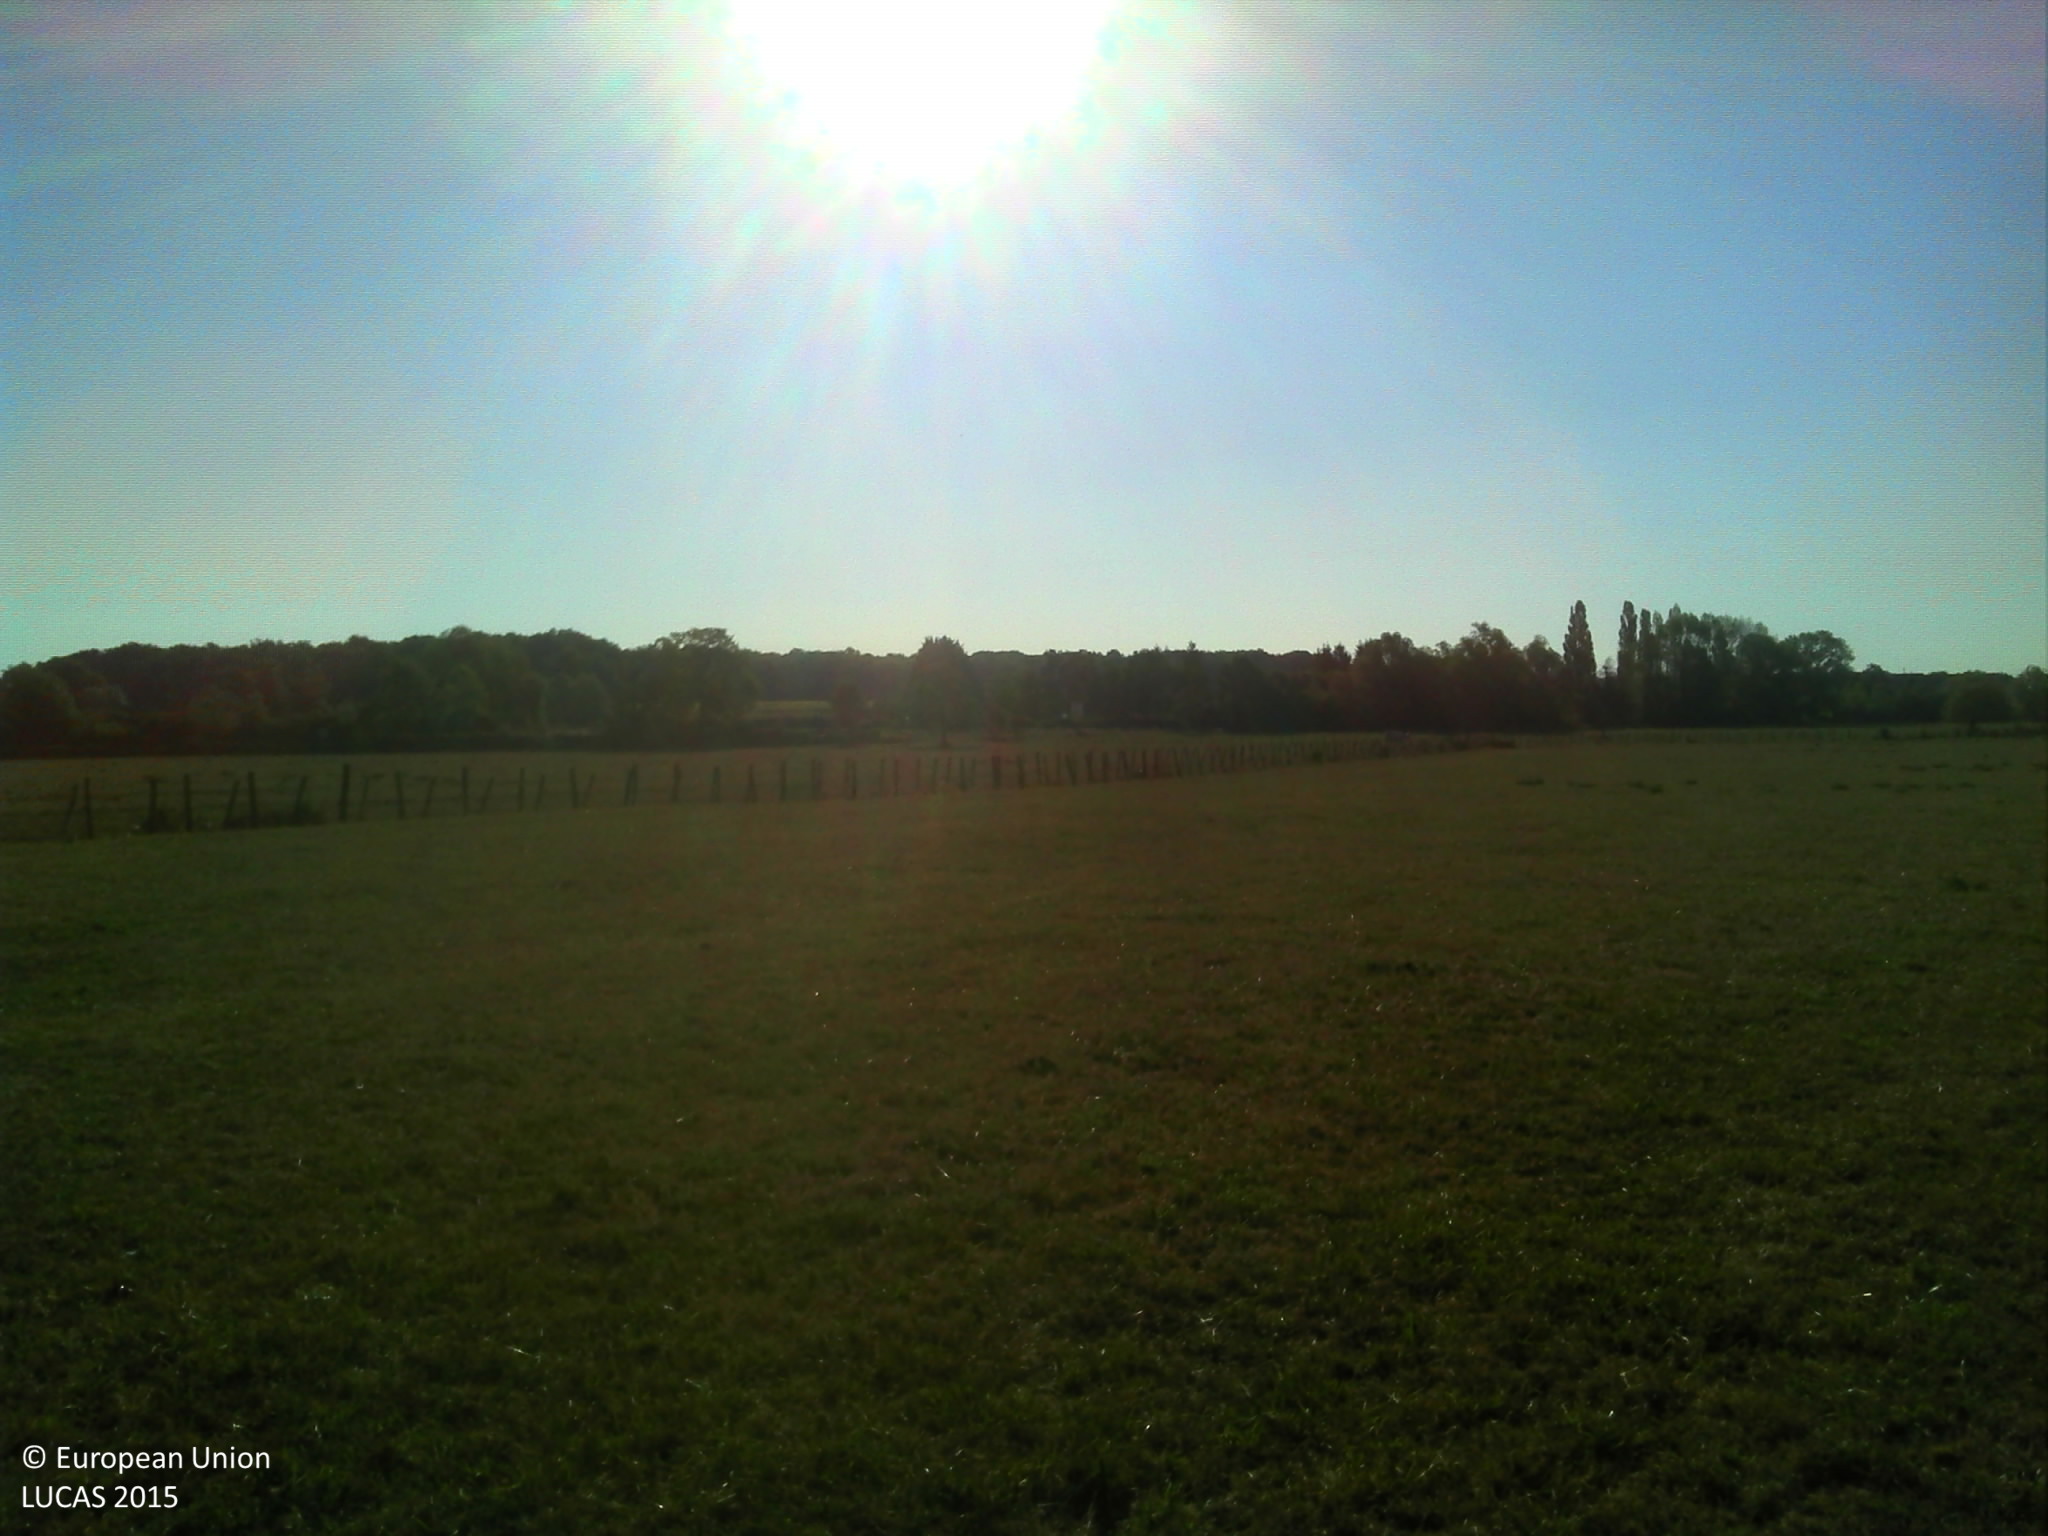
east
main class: Grassland
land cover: Grassland without tree/shrub cover
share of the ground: > 75 %
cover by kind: herbaceous plants 100 %
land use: Agriculture (excluding fallow land and kitchen gardens)
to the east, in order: Grassland without tree/shrub cover; Fences; Ditches and canals; Fences; Grassland without tree/shrub cover
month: August
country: FR
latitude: 46.8176
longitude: 4.7453
